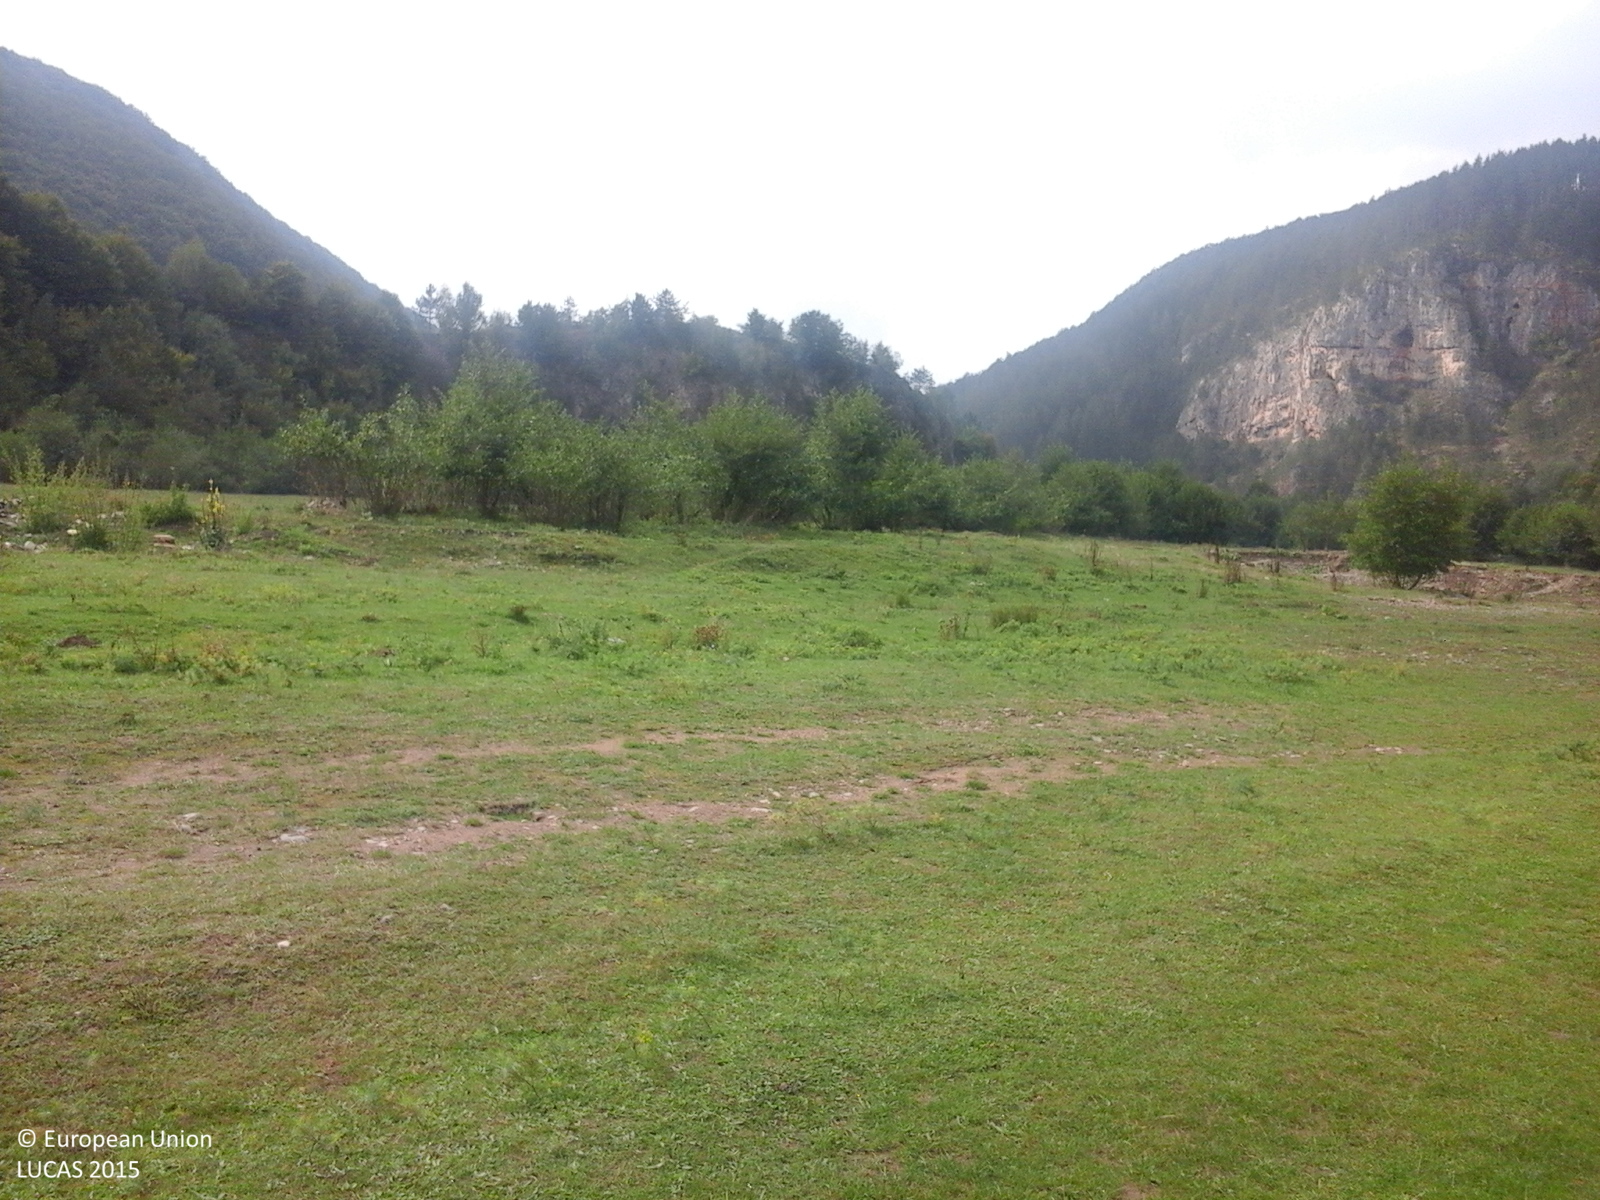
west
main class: Grassland
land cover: Grassland without tree/shrub cover
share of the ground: > 75 %
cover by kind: herbaceous plants 100 %
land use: Agriculture (excluding fallow land and kitchen gardens)
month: September
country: RO
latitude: 46.9357
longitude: 22.5731
